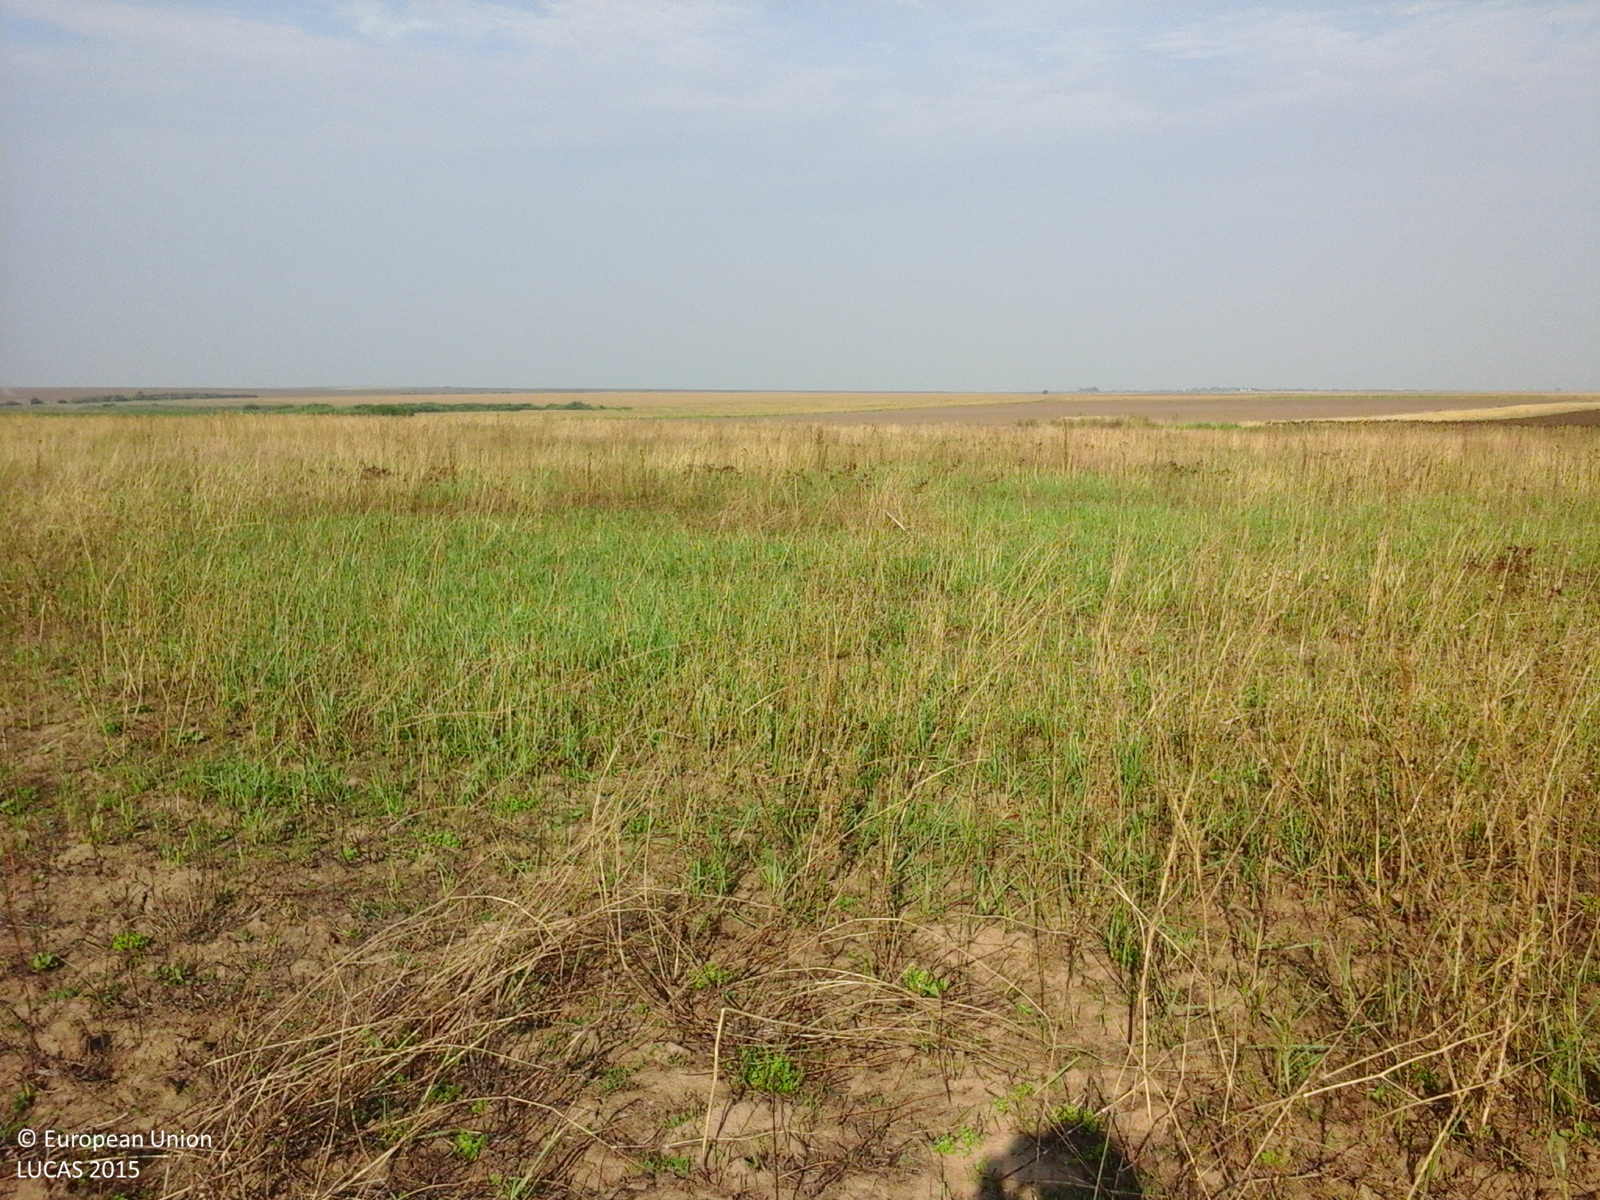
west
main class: Grassland
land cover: Grassland without tree/shrub cover
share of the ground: > 75 %
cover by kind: herbaceous plants 100 %
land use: Agriculture (excluding fallow land and kitchen gardens)
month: August
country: RO
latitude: 46.0616
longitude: 21.4492
